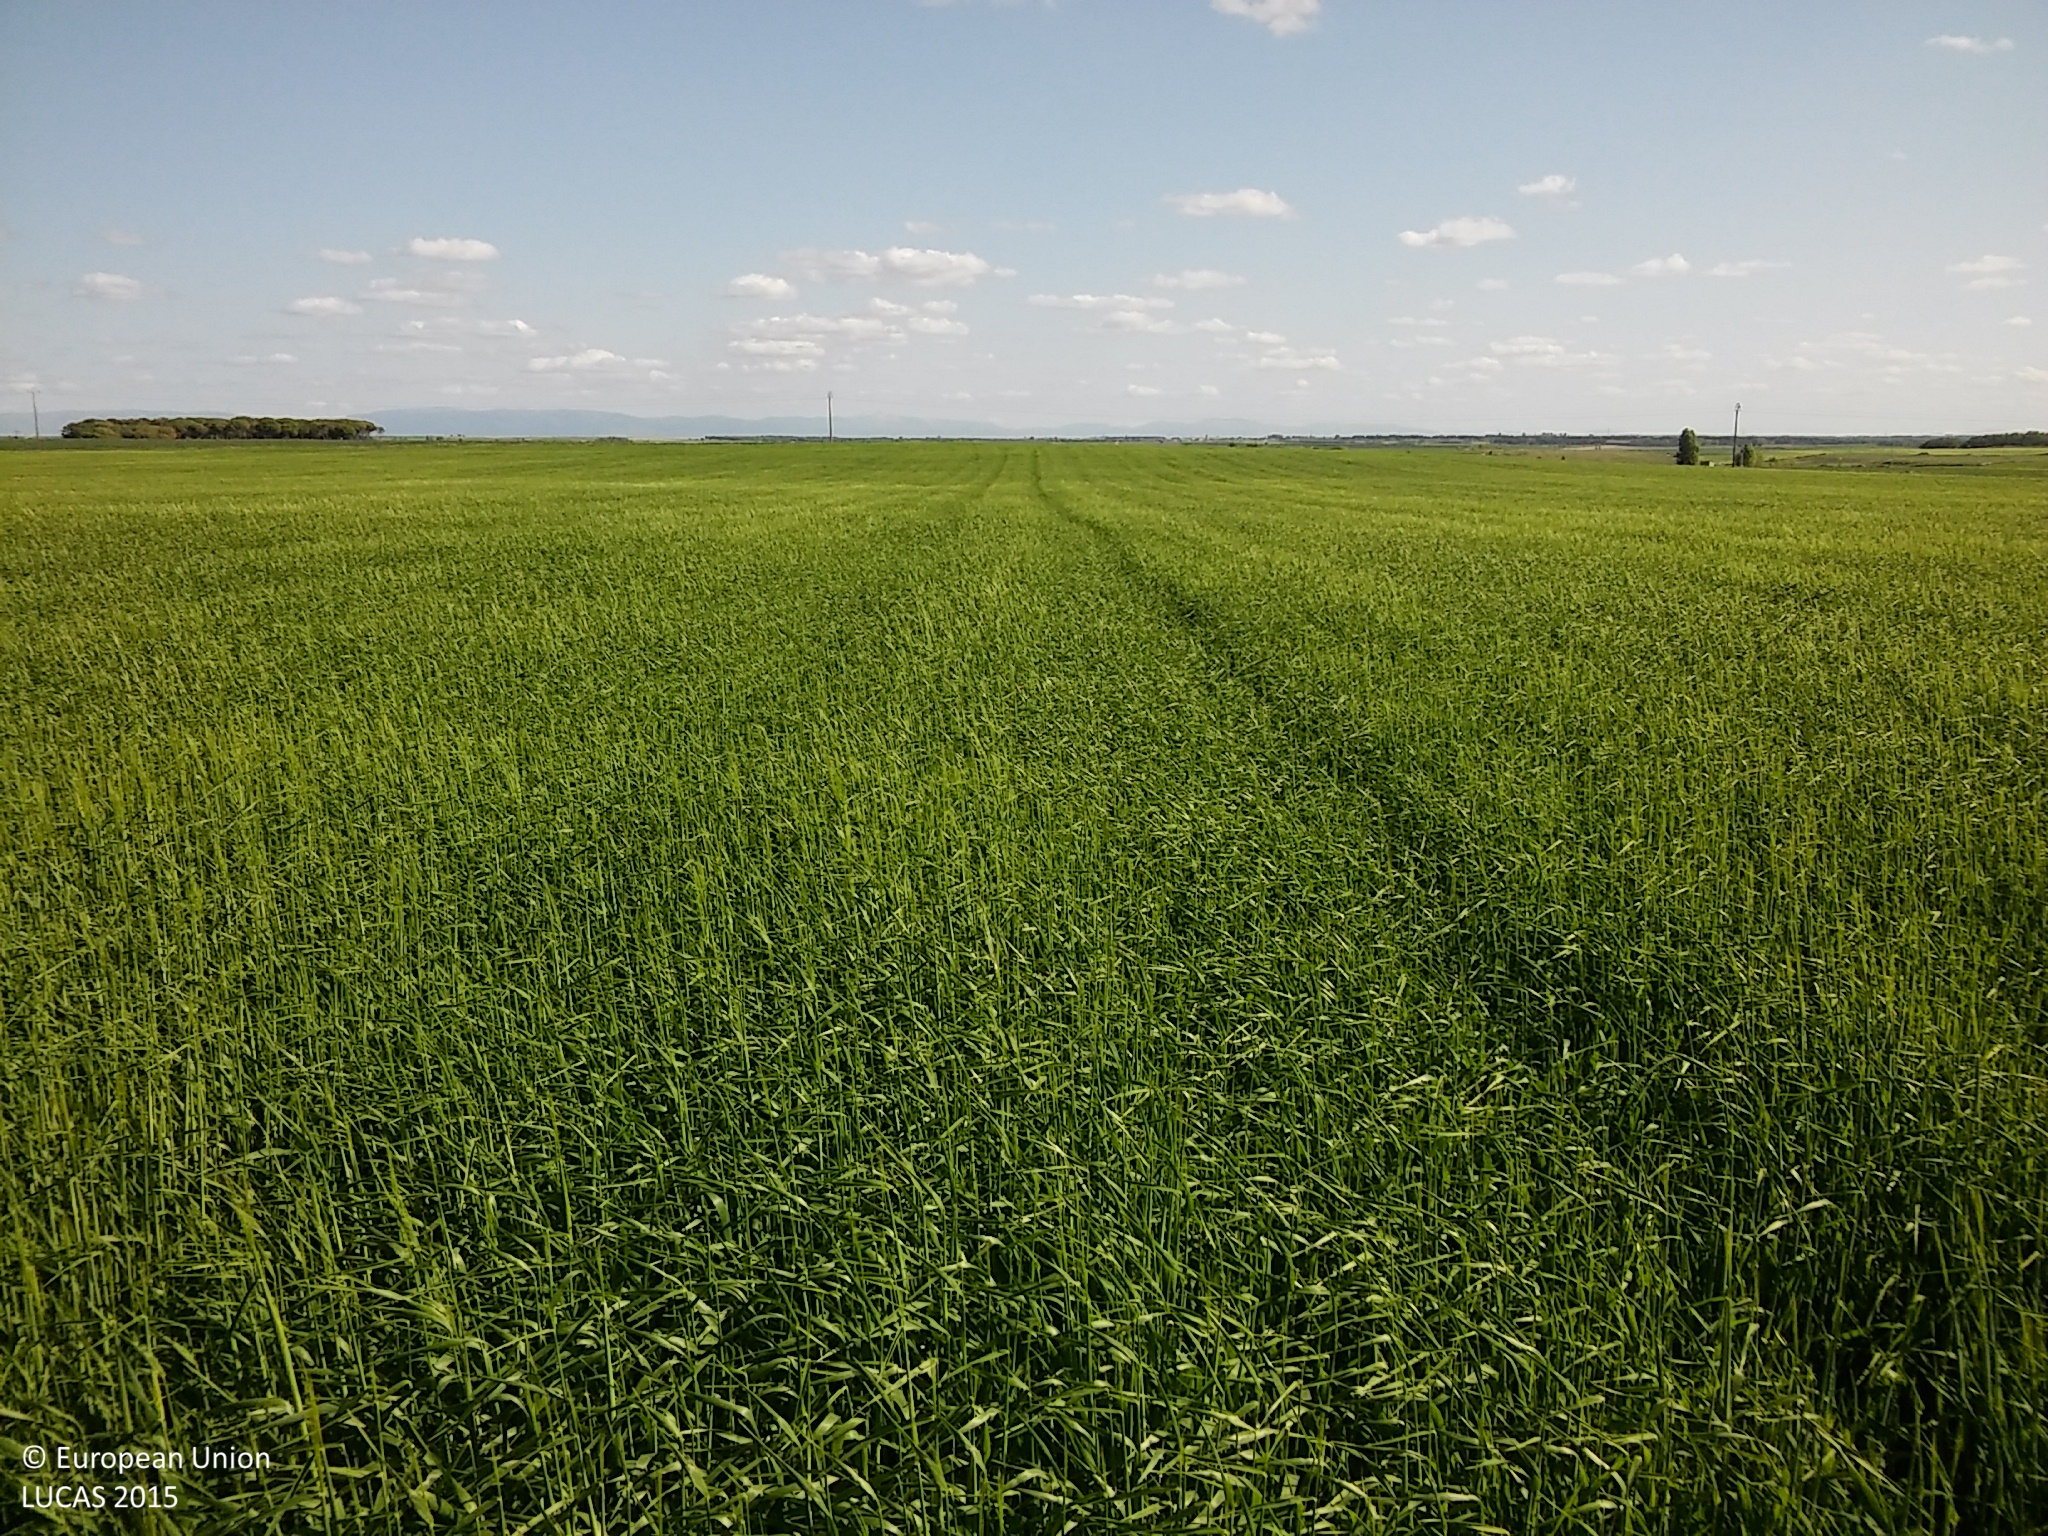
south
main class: Cropland
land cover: Barley
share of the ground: > 75 %
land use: Agriculture (excluding fallow land and kitchen gardens)
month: May
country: ES
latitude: 41.4219
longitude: -4.1152
